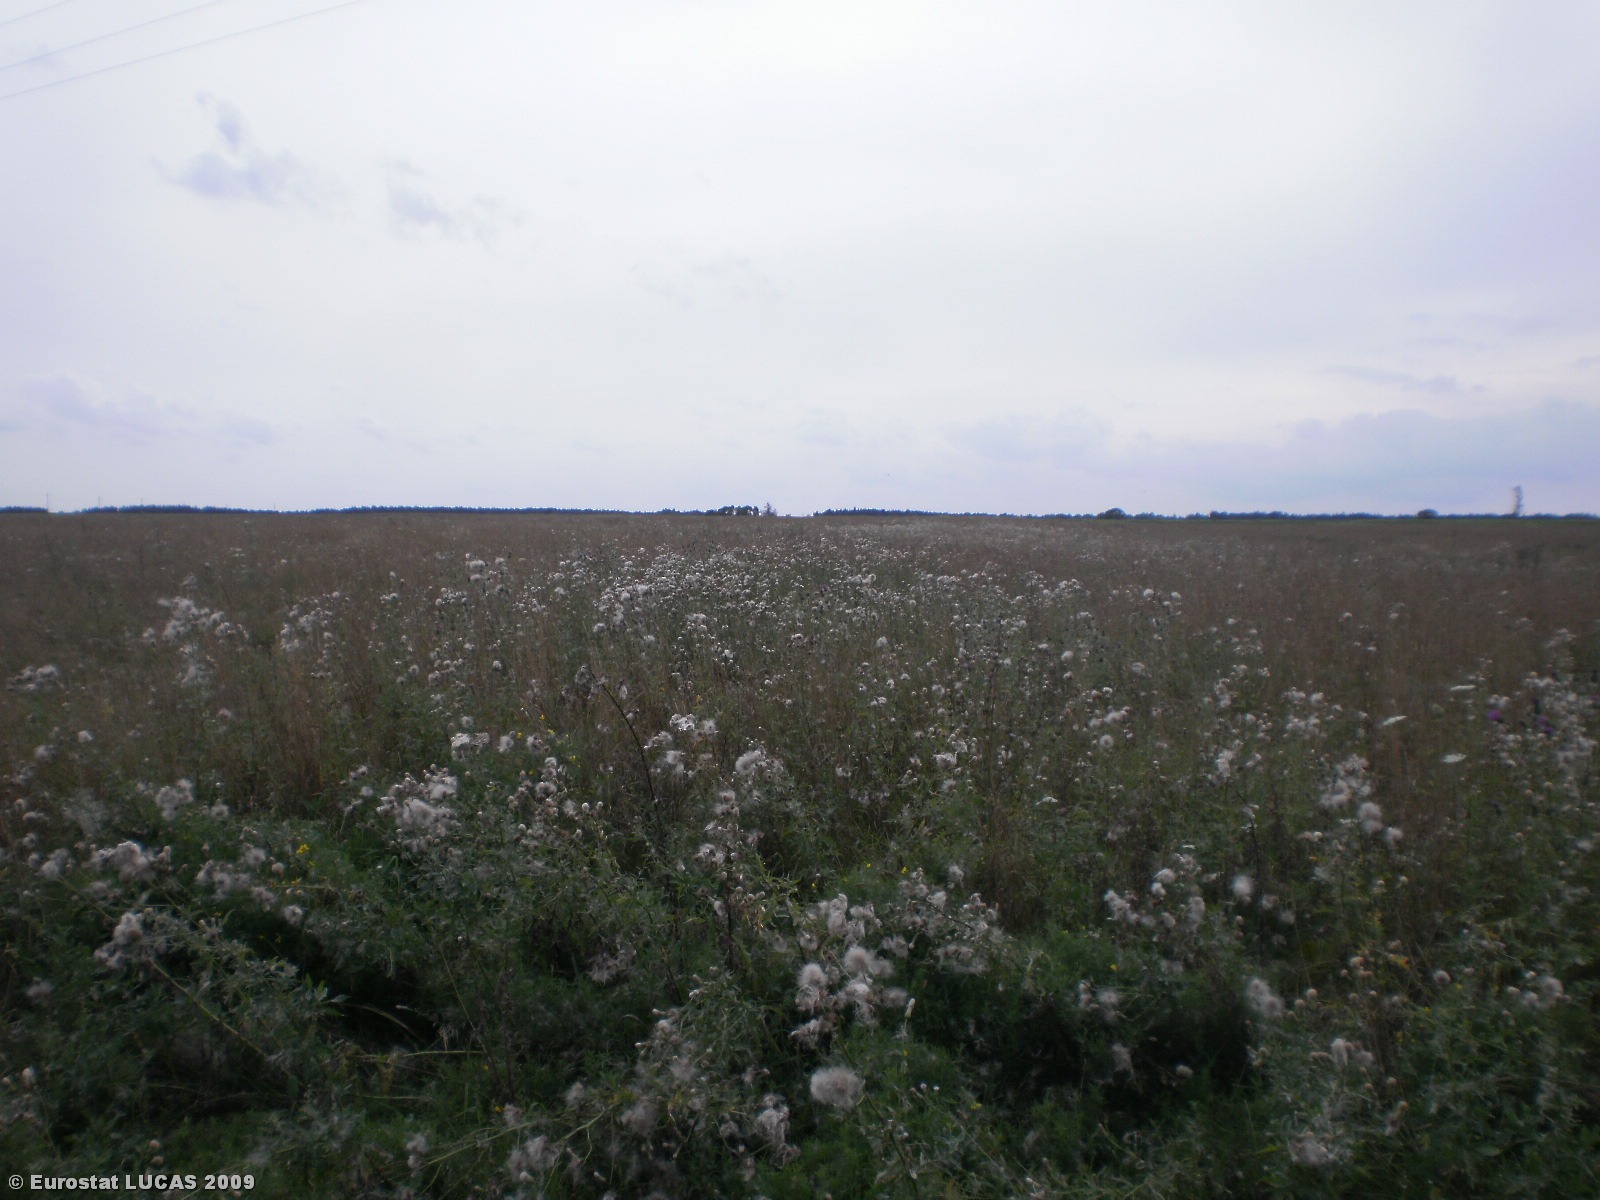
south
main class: Grassland
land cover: Grassland without tree/shrub cover
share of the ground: > 75 %
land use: Agriculture (excluding fallow land and kitchen gardens)
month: August
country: LT
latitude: 54.9954
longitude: 24.6260
